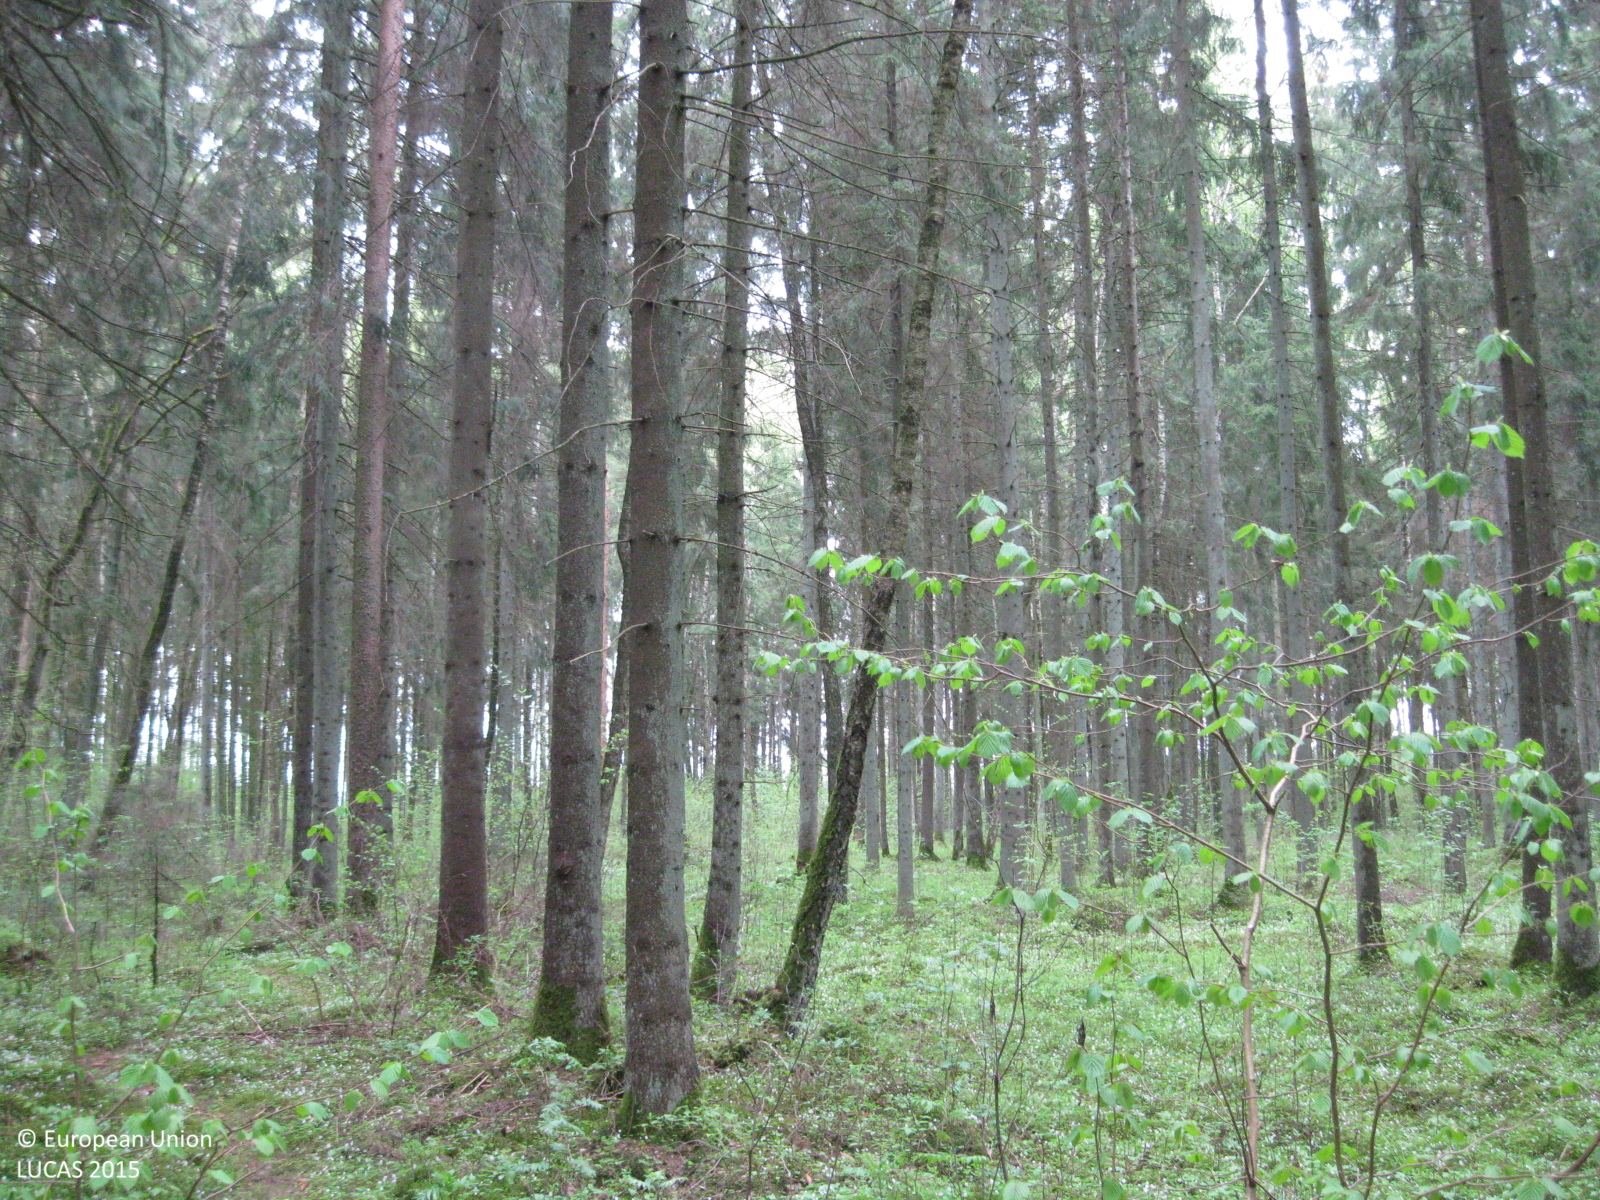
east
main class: Woodland
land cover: Spruce dominated coniferous woodland
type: hemiboreal forest and nemoral coniferous forest and mixed broadleaved-coniferous forest
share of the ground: > 75 %
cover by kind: coniferous forest trees 75 %, lichens and mosses 10 %, broadleaved forest trees 5 %, shrubs 5 %, herbaceous plants 5 %
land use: Forestry
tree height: > 5 m
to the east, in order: Spruce dominated coniferous woodland; Spruce dominated mixed woodland; Other mixed woodland; Paved roads, cycling and walking lanes; Grass margins; Common wheat
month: May
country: LT
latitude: 56.1519
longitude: 24.4395
